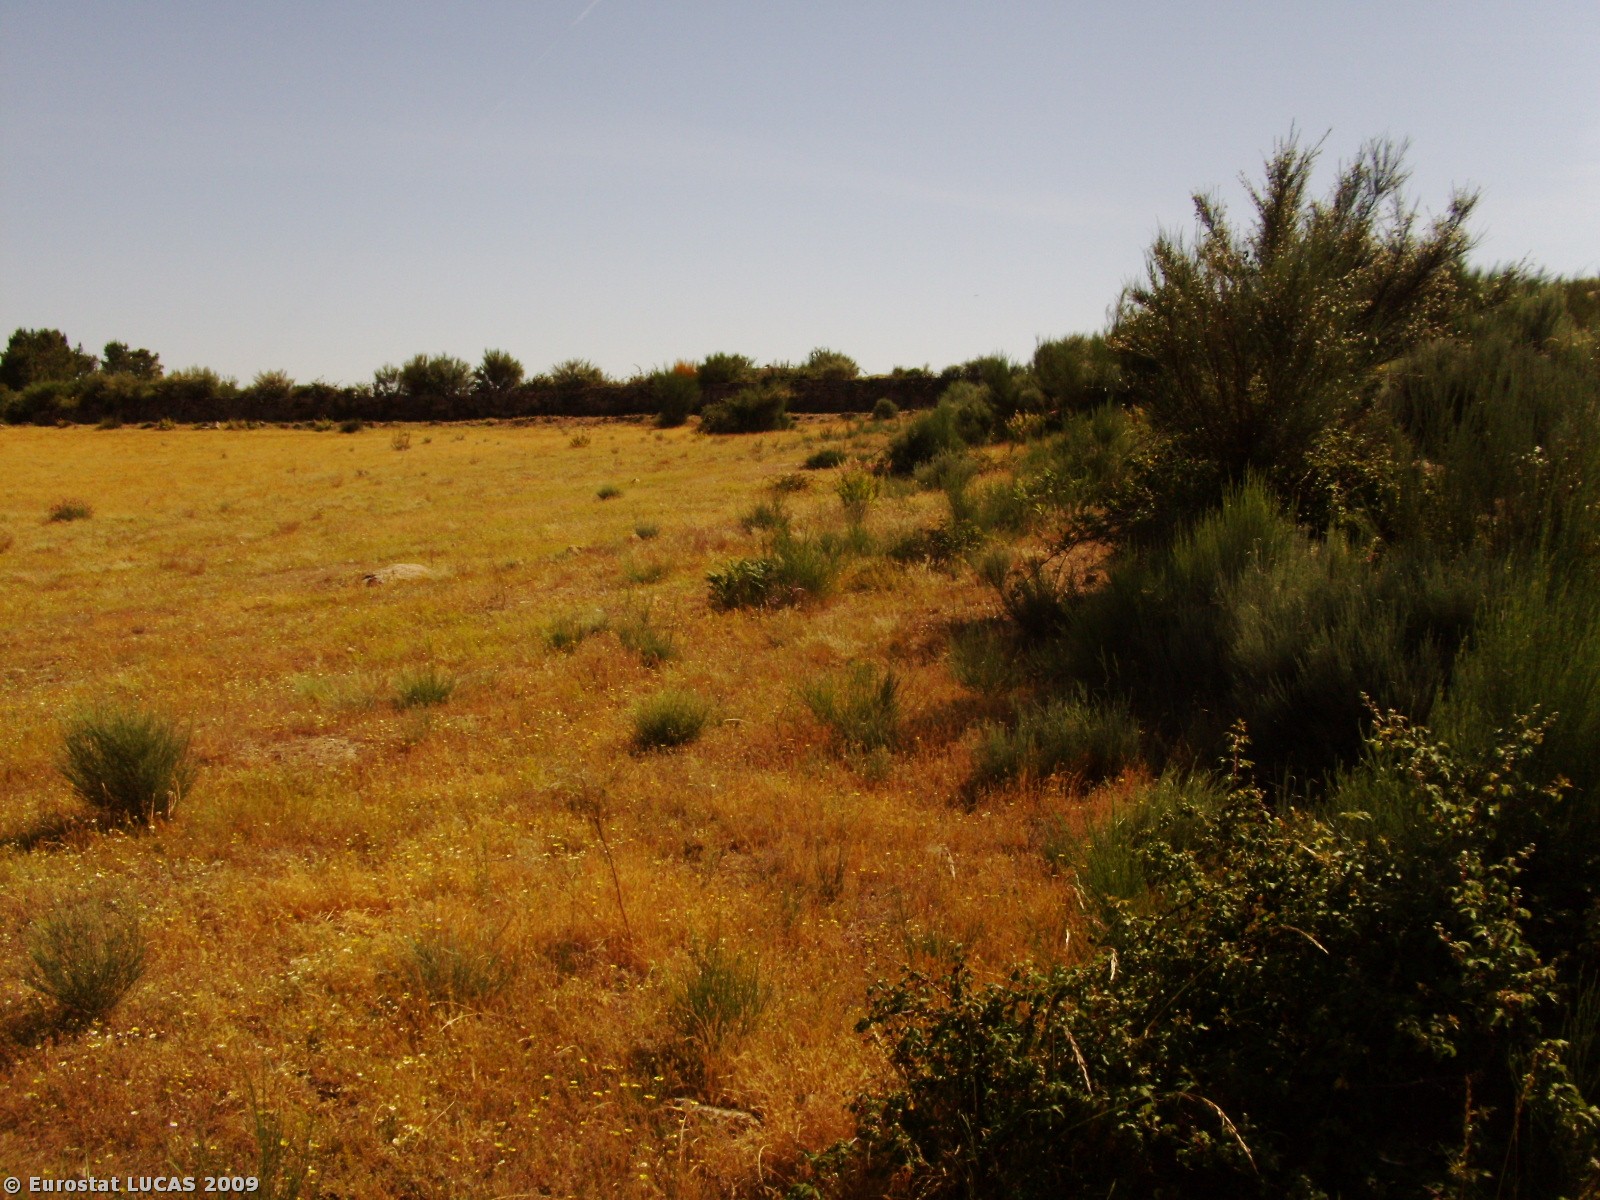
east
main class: Shrubland
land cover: Shrubland without tree cover
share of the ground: > 75 %
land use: Unused
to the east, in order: Shrubland without tree cover; Spontaneously vegetated surfaces; Tracks; Shrubland without tree cover; Tracks; Shrubland without tree cover; Spontaneously vegetated surfaces; Shrubland without tree cover
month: June
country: PT
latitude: 40.5873
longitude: -7.4680
